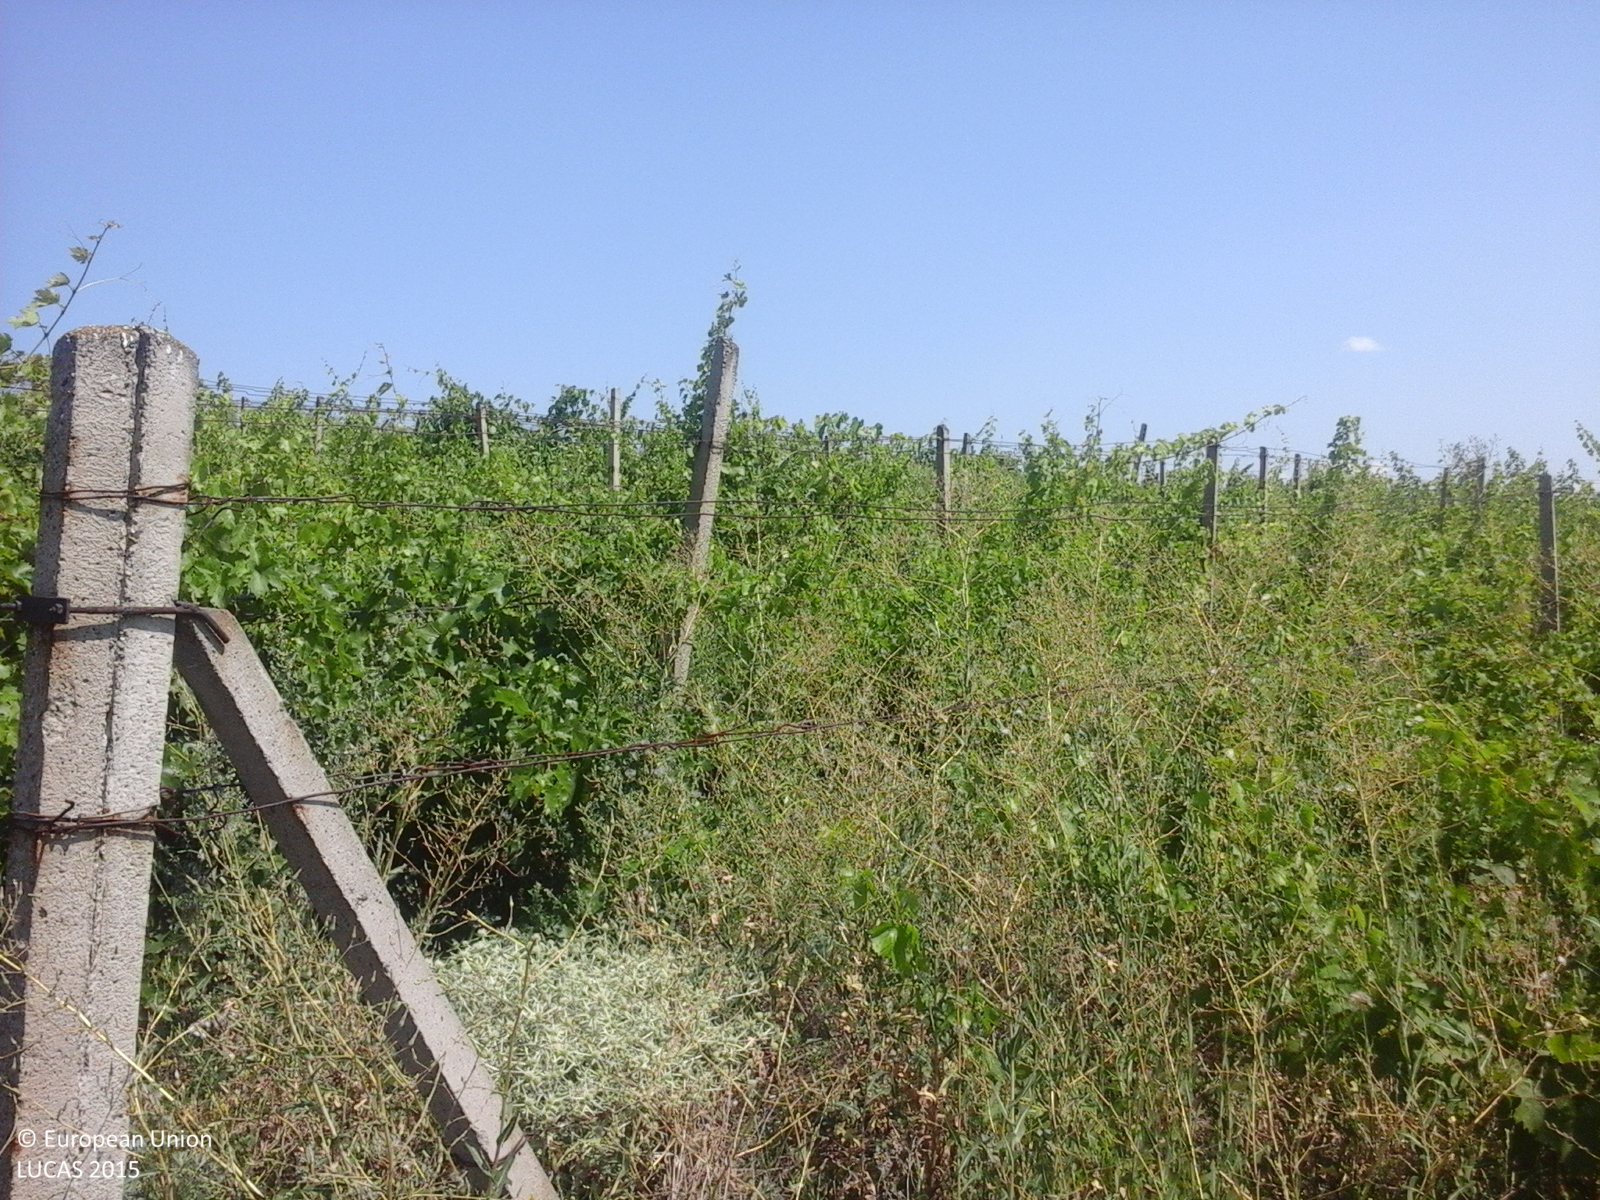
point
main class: Cropland
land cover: Vineyards
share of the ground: > 75 %
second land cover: Spontaneously vegetated surfaces
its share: 10 - 25 %
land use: Agriculture (excluding fallow land and kitchen gardens)
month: July
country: RO
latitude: 46.3849
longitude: 27.2800
